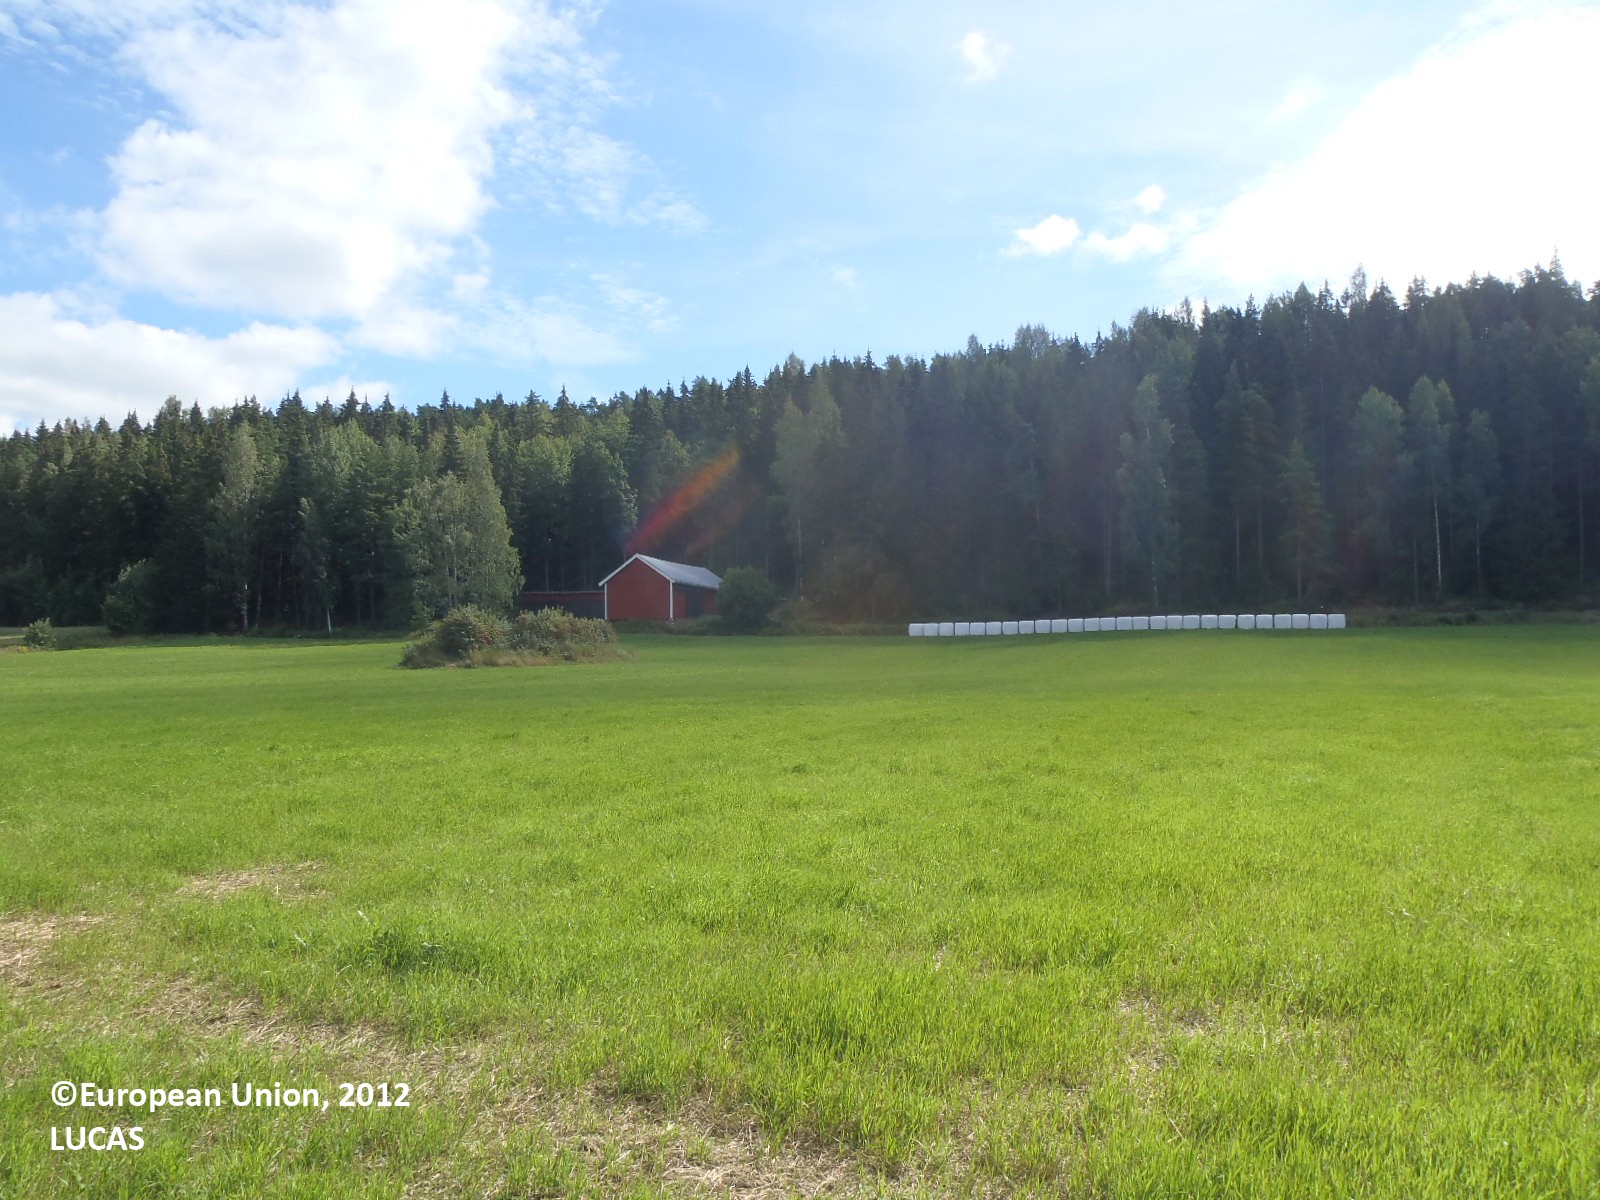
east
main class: Cropland
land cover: Temporary grasslands
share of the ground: > 75 %
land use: Agriculture (excluding fallow land and kitchen gardens)
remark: Harvested field
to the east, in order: Temporary grasslands; Shrubland without tree cover; Temporary grasslands; Grassland without tree/shrub cover; Spruce dominated mixed woodland; Artificial constructions; Spruce dominated mixed woodland; Pine dominated mixed woodland
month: August
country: FI
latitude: 60.3953
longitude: 22.4279
